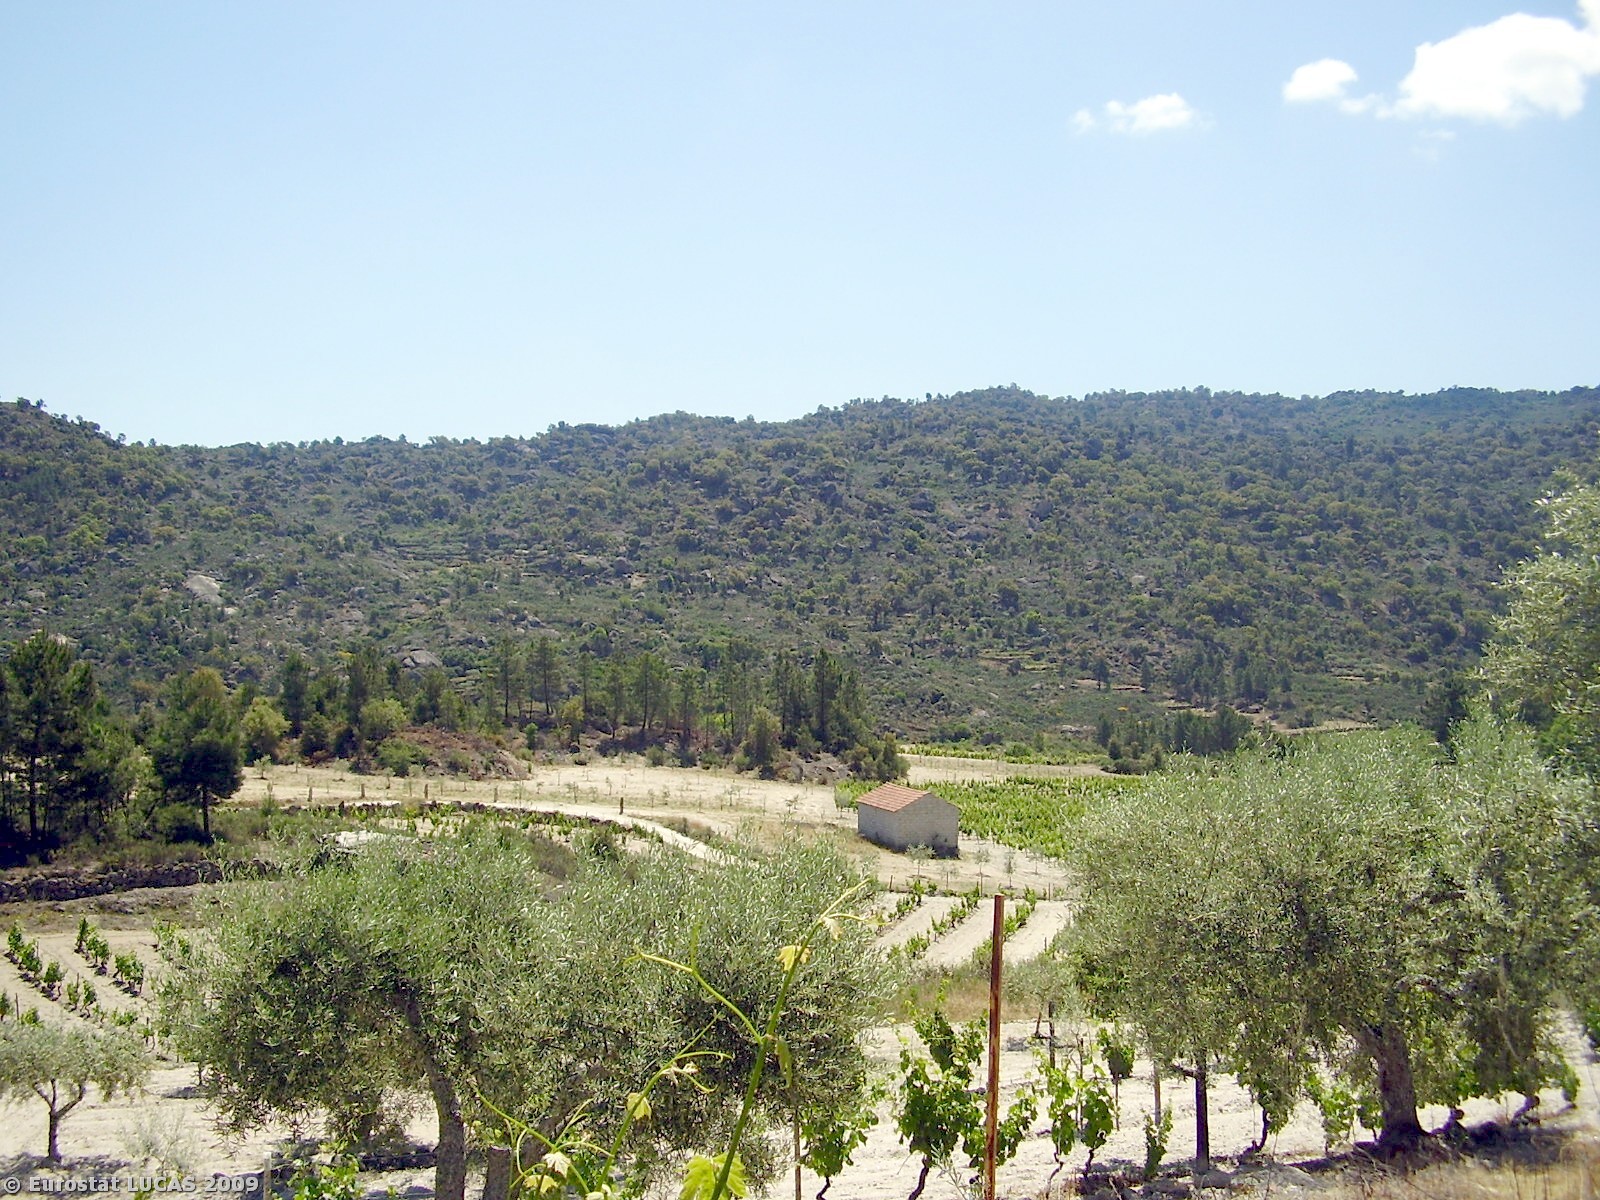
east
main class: Cropland
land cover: Vineyards
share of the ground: < 10 %
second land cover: Olive groves
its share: < 10 %
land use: Agriculture (excluding fallow land and kitchen gardens)
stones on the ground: < 10 %
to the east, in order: Vineyards; Dry stone walls; Vineyards; Other structural elements; Vineyards; Other structural elements; Vineyards; Other structural elements; Vineyards; Other structural elements; Dry stone walls; Ditches and canals; Vineyards; Ditches and canals; Dry stone walls; Rock outcrops; Vineyards; Dry stone walls; Tracks; Olive groves; Tracks; Vineyards; Ponds and wetlands; Ditches and canals; Vineyards; Other structural elements; Vineyards; Other structural elements; Dry stone walls; Olive groves; Other structural elements; Olive groves
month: May
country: PT
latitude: 41.3069
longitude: -7.2577
